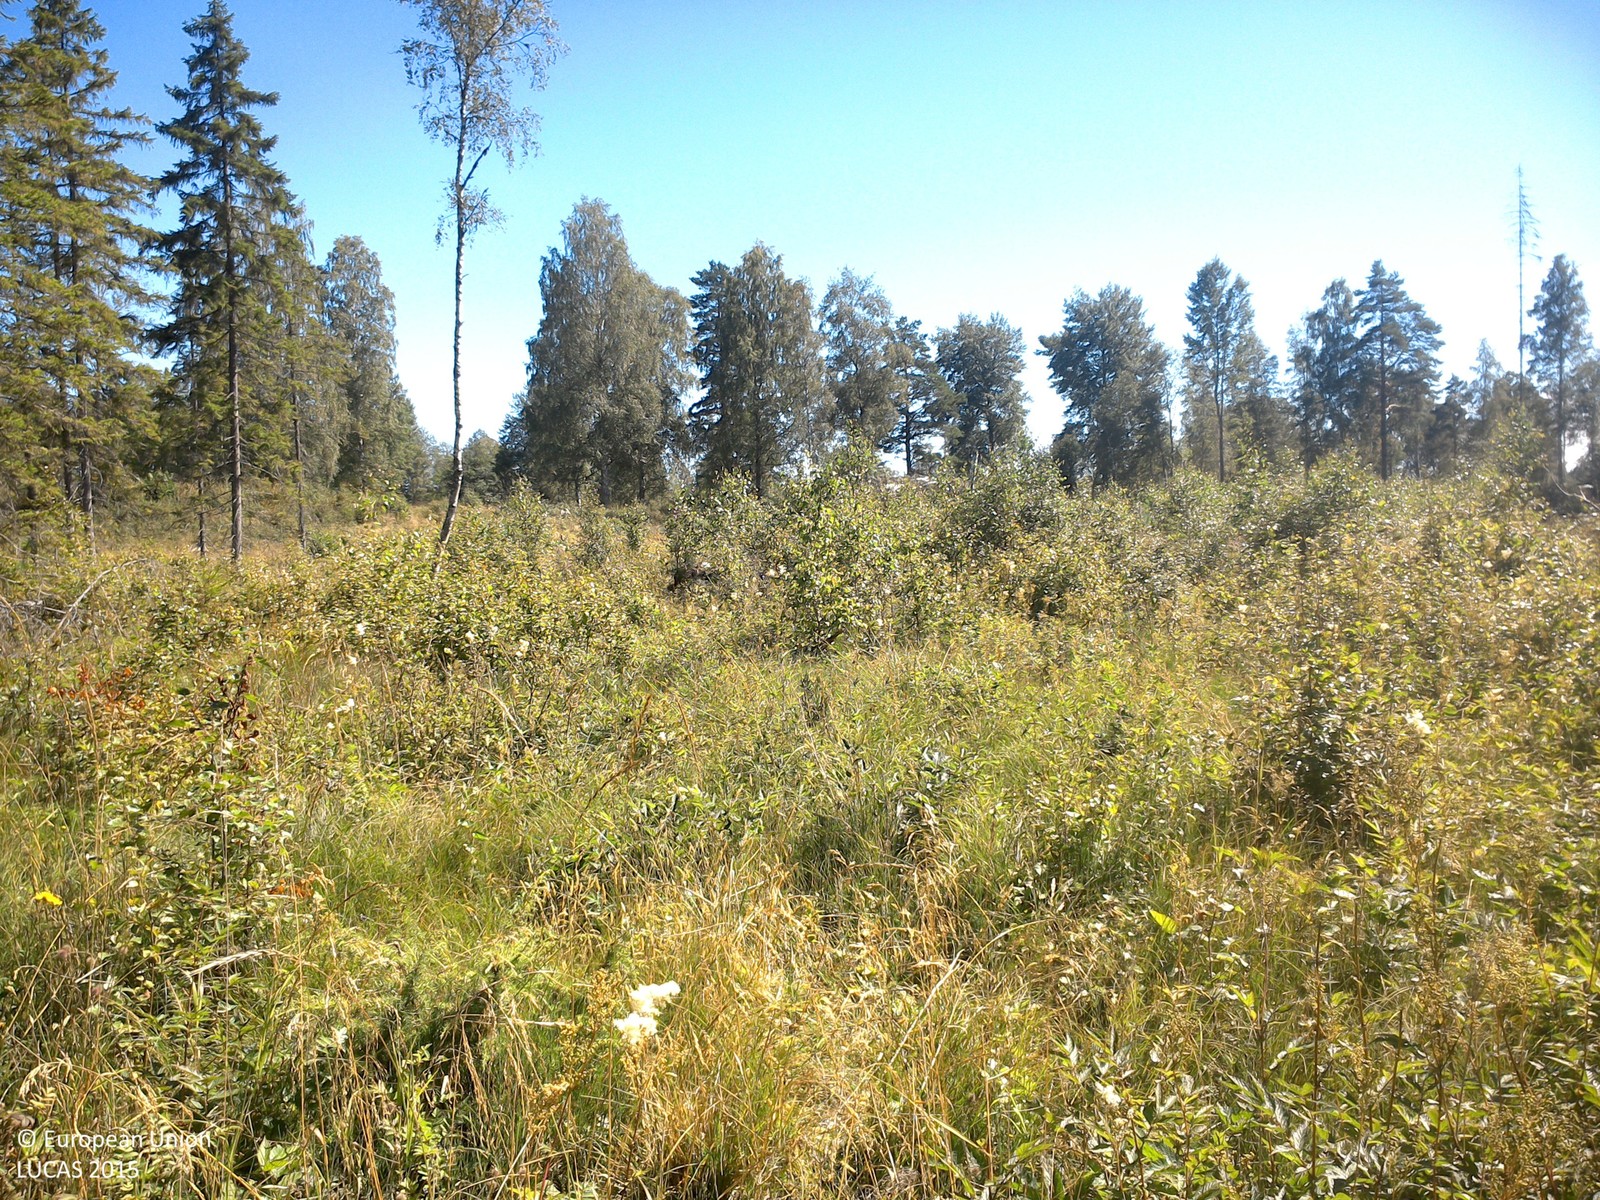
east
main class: Grassland
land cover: Spontaneously vegetated surfaces
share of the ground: > 75 %
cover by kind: herbaceous plants 95 %, shrubs 5 %
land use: Forestry
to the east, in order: Spontaneously vegetated surfaces; Broadleaved woodland; Spontaneously vegetated surfaces; Shrubland with sparse tree cover; Spontaneously vegetated surfaces; Shrubland with sparse tree cover; Paved roads, cycling and walking lanes; Ditches and canals; Fences; Grassland with sparse tree/shrub cover; Fences; Pine dominated mixed woodland
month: August
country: SE
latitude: 58.2866
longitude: 15.0598
